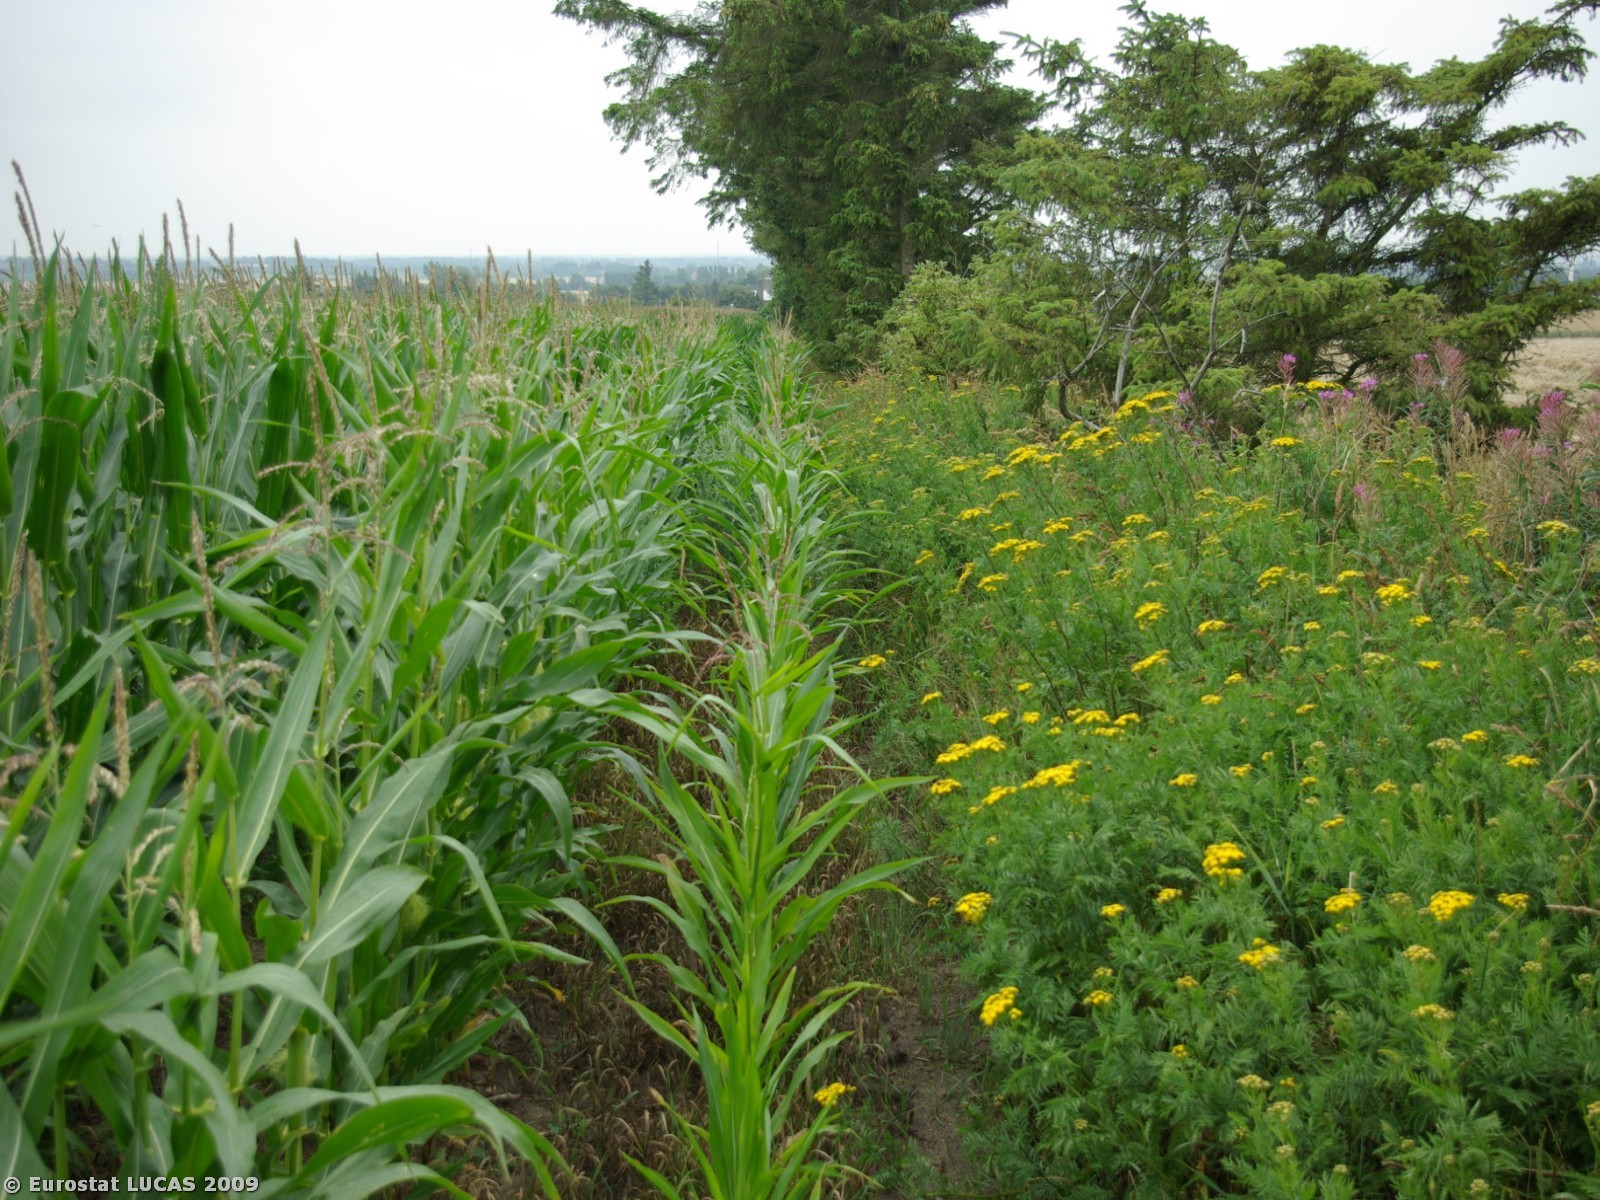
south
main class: Cropland
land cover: Maize
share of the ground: > 75 %
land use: Agriculture (excluding fallow land and kitchen gardens)
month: July
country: DK
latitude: 55.1574
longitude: 8.7925
